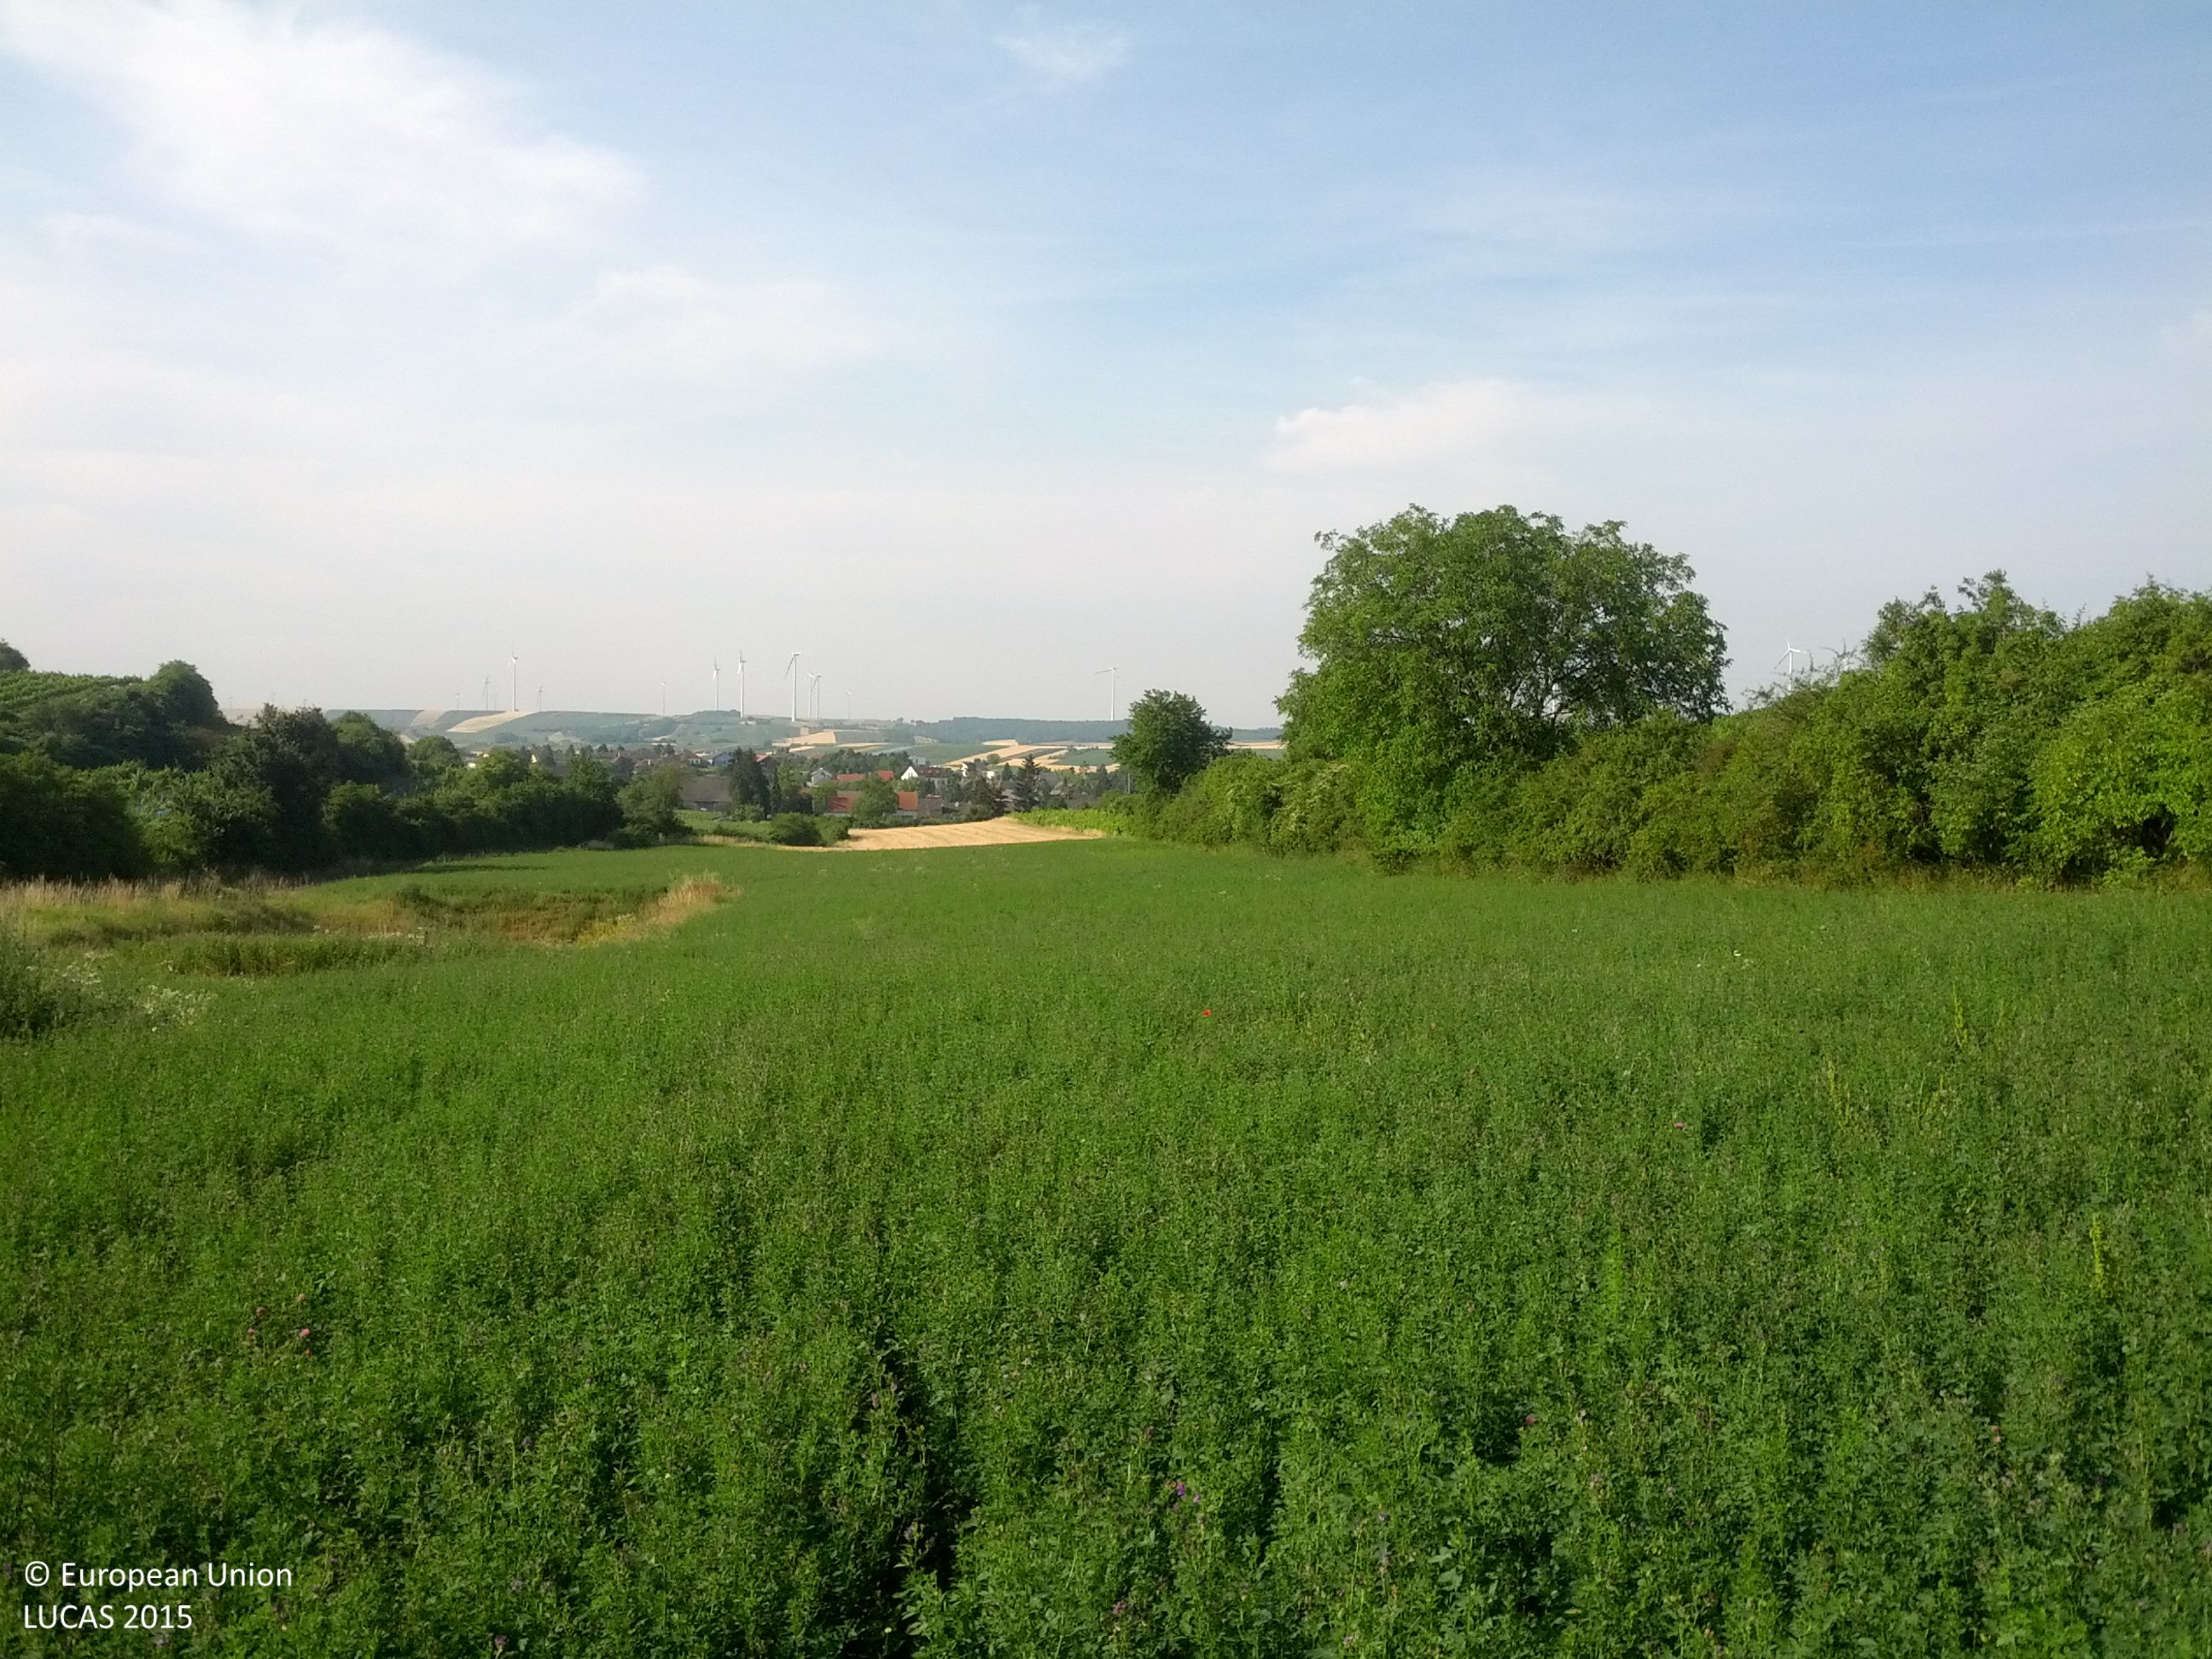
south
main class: Cropland
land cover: Lucerne
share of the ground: > 75 %
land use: Agriculture (excluding fallow land and kitchen gardens)
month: June
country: AT
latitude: 48.6744
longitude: 16.6204
